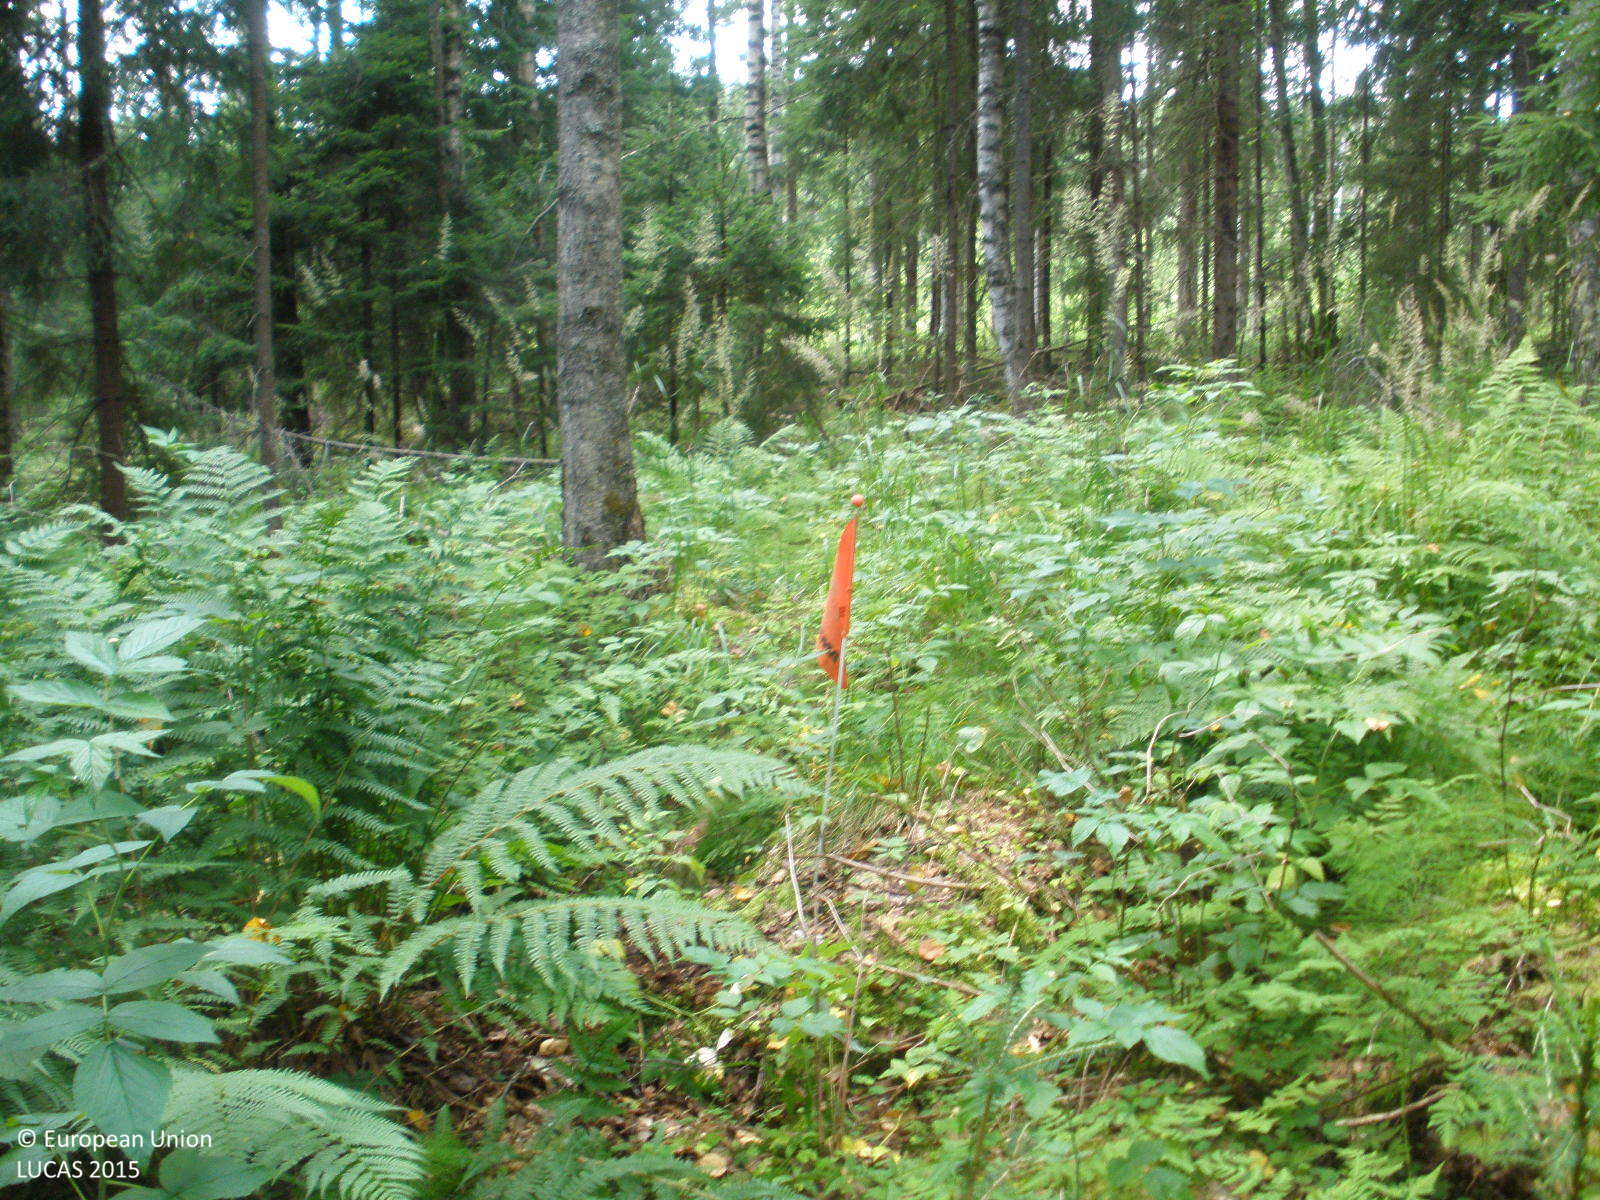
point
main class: Woodland
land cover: Spruce dominated mixed woodland
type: boreal forest
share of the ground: > 75 %
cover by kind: broadleaved forest trees 55 %, coniferous forest trees 30 %, herbaceous plants 10 %, lichens and mosses 5 %
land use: Forestry
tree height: > 5 m
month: August
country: FI
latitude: 61.0027
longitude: 24.6973
